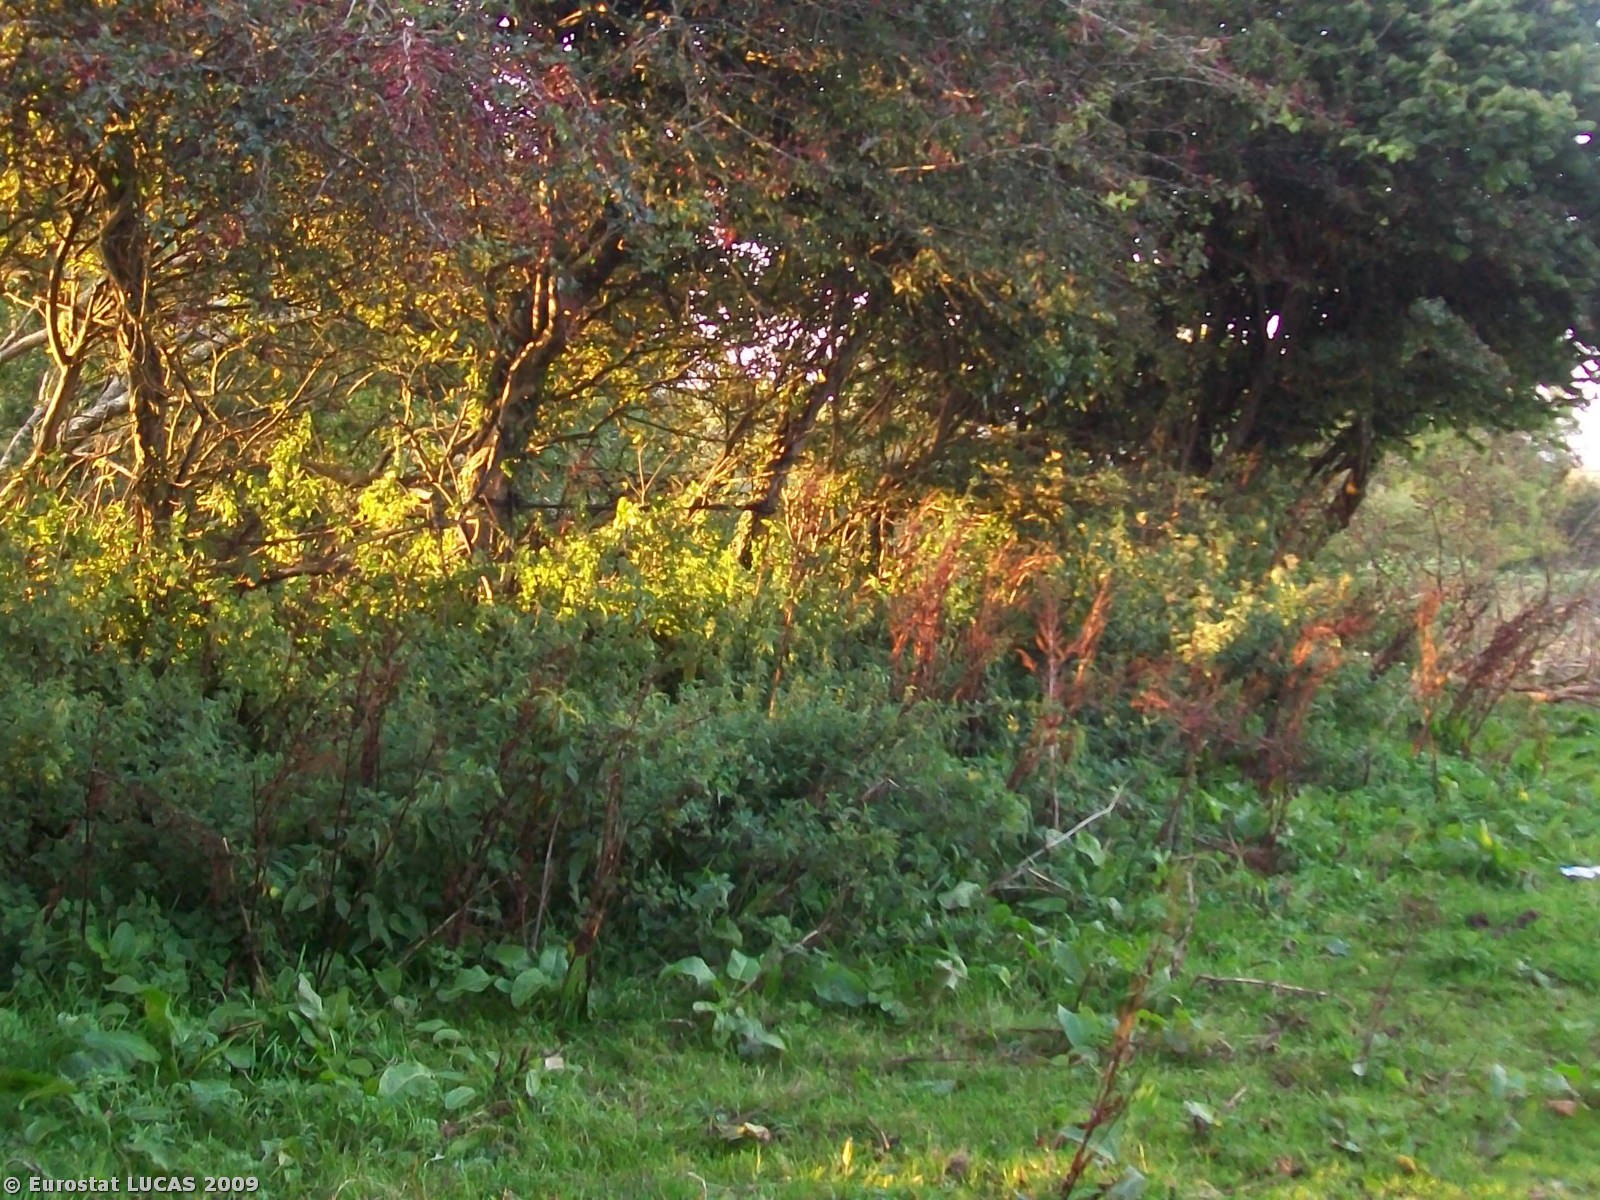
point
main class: Grassland
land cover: Grassland without tree/shrub cover
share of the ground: > 75 %
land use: Agriculture (excluding fallow land and kitchen gardens)
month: September
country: GB
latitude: 51.6844
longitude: -4.9117
